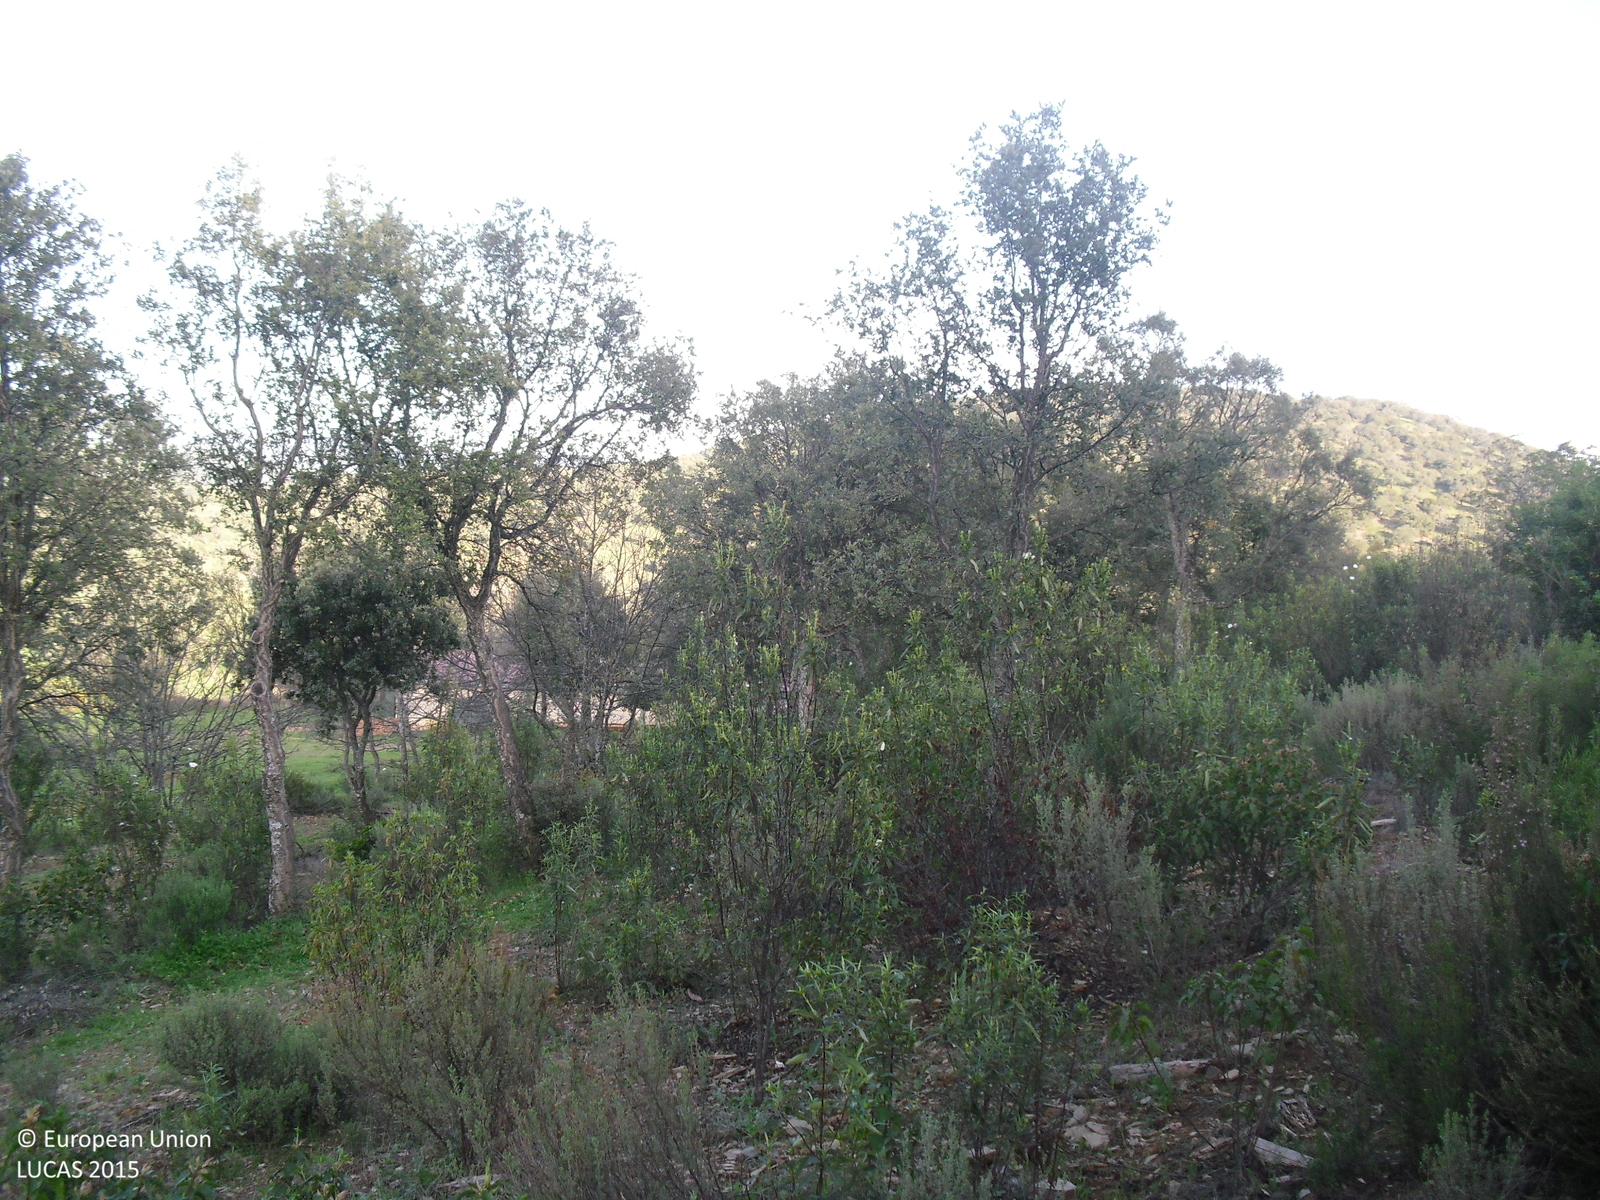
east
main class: Woodland
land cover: Broadleaved woodland
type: broadleaved evergreen forest
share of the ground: 10 - 25 %
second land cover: Shrubland without tree cover
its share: > 75 %
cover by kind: shrubs 70 %, broadleaved forest trees 20 %, herbaceous plants 10 %
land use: Forestry
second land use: Agriculture (excluding fallow land and kitchen gardens)
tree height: > 5 m
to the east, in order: Broadleaved woodland; Shrubland without tree cover; Grassland without tree/shrub cover; Fences; Grass margins; Tracks; Shruby margins; Fences; Broadleaved woodland; Fences; Broadleaved woodland; Fences; Broadleaved woodland
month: April
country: ES
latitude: 39.4269
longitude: -5.3002
